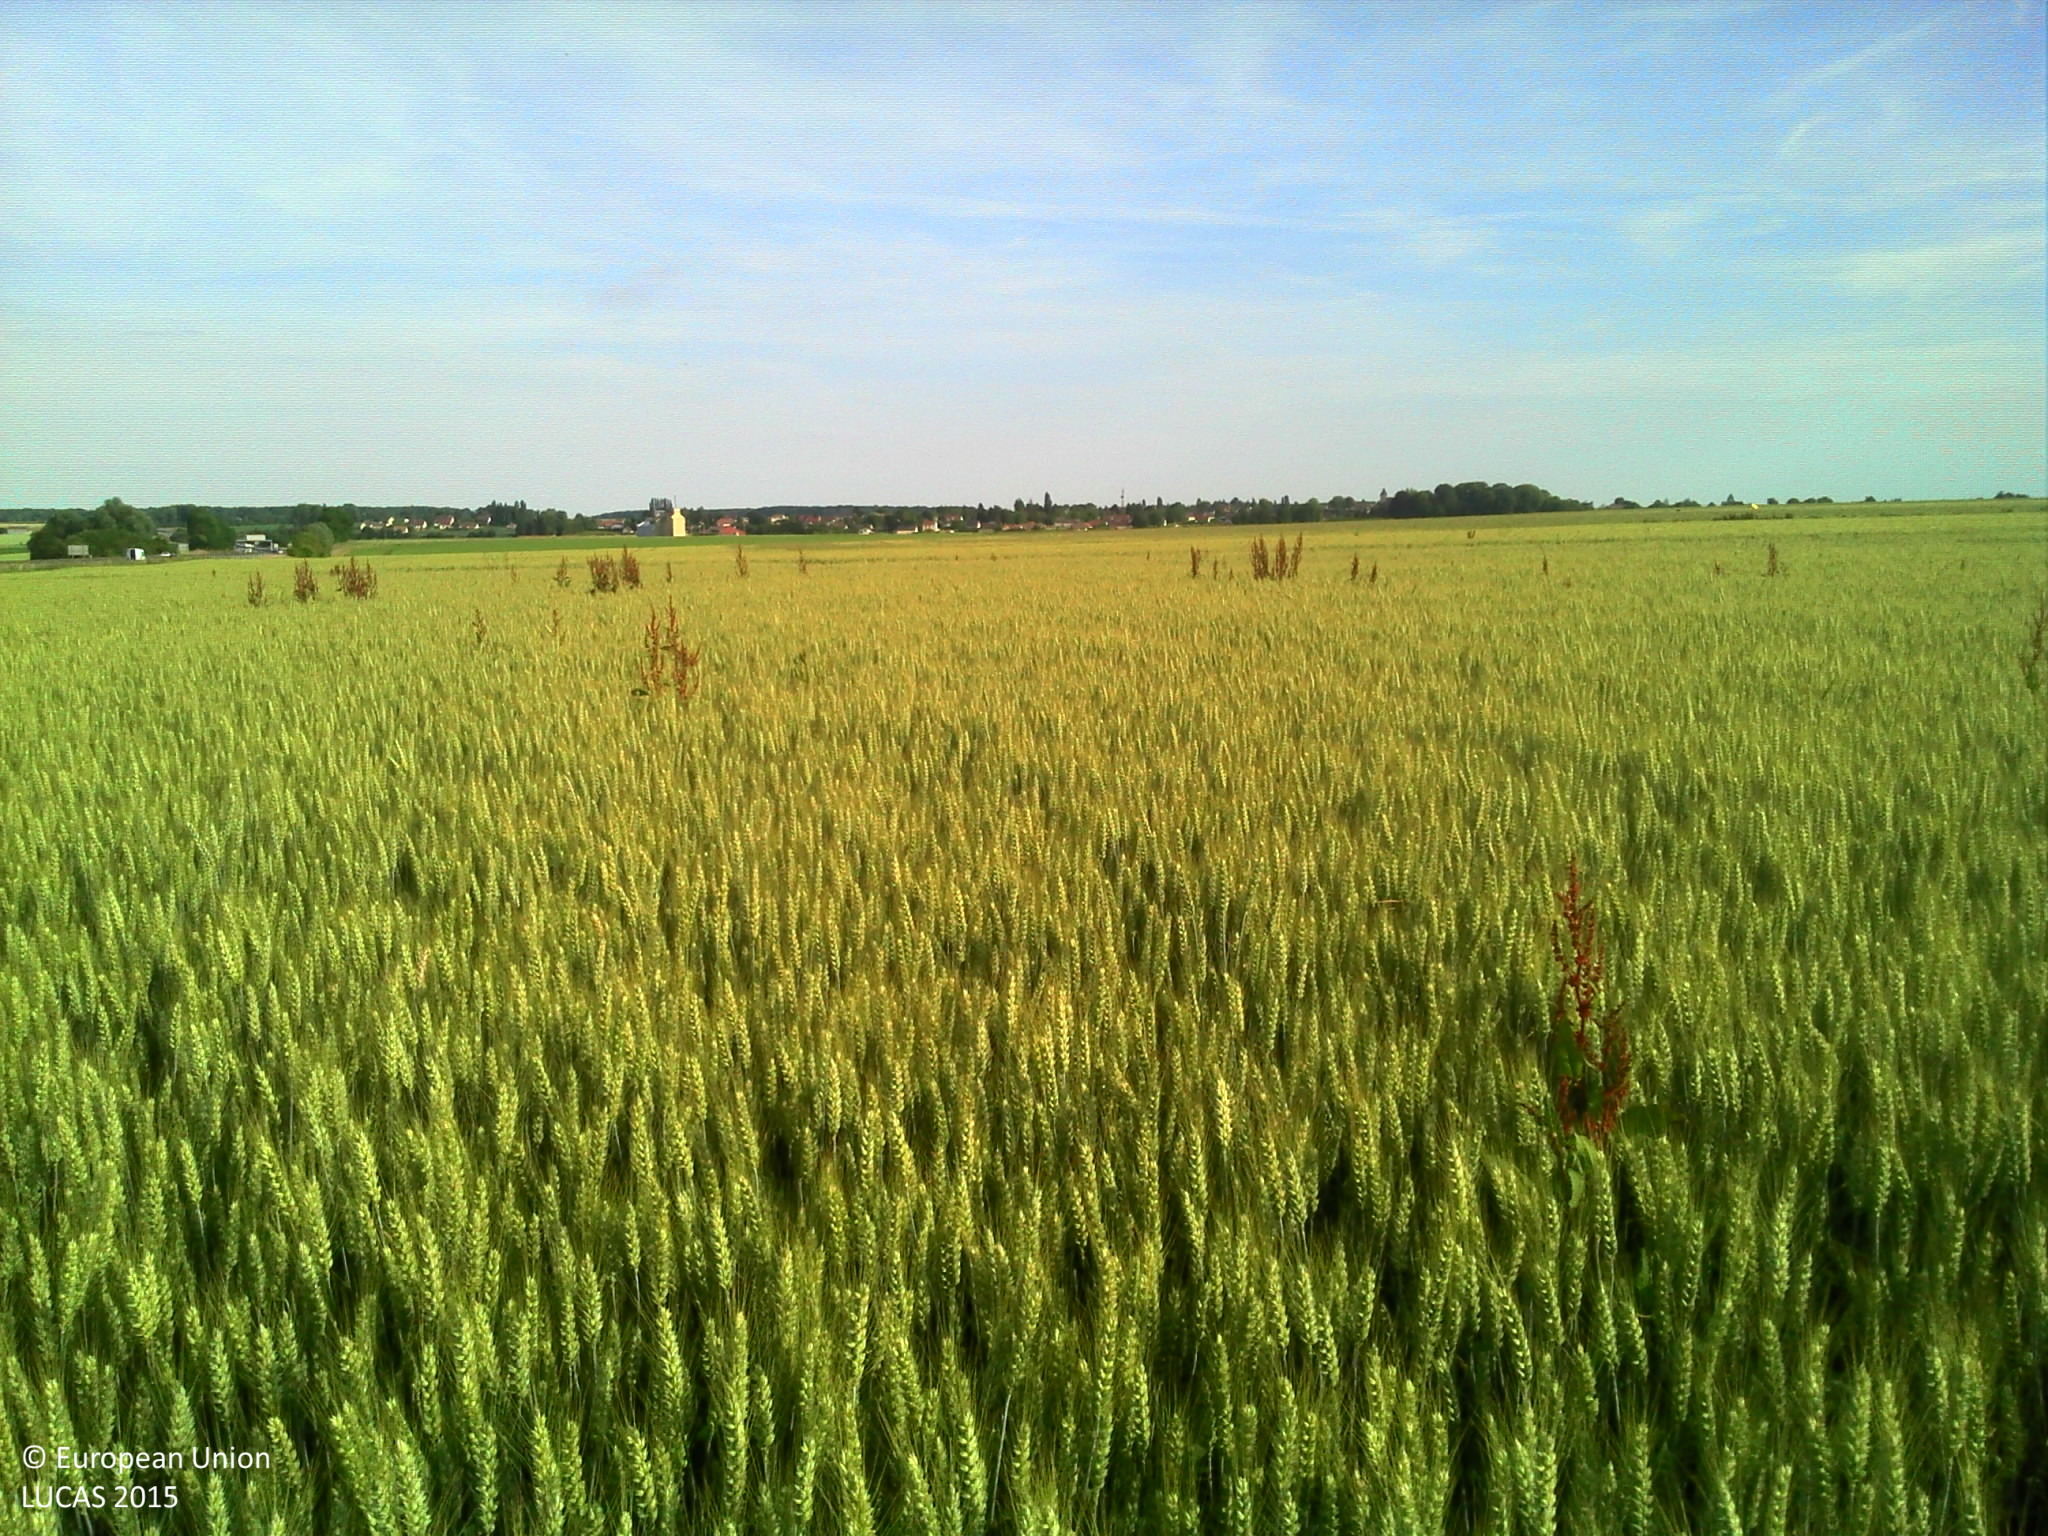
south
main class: Cropland
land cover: Common wheat
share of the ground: > 75 %
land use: Agriculture (excluding fallow land and kitchen gardens)
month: June
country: FR
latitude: 49.1773
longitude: 1.2418
